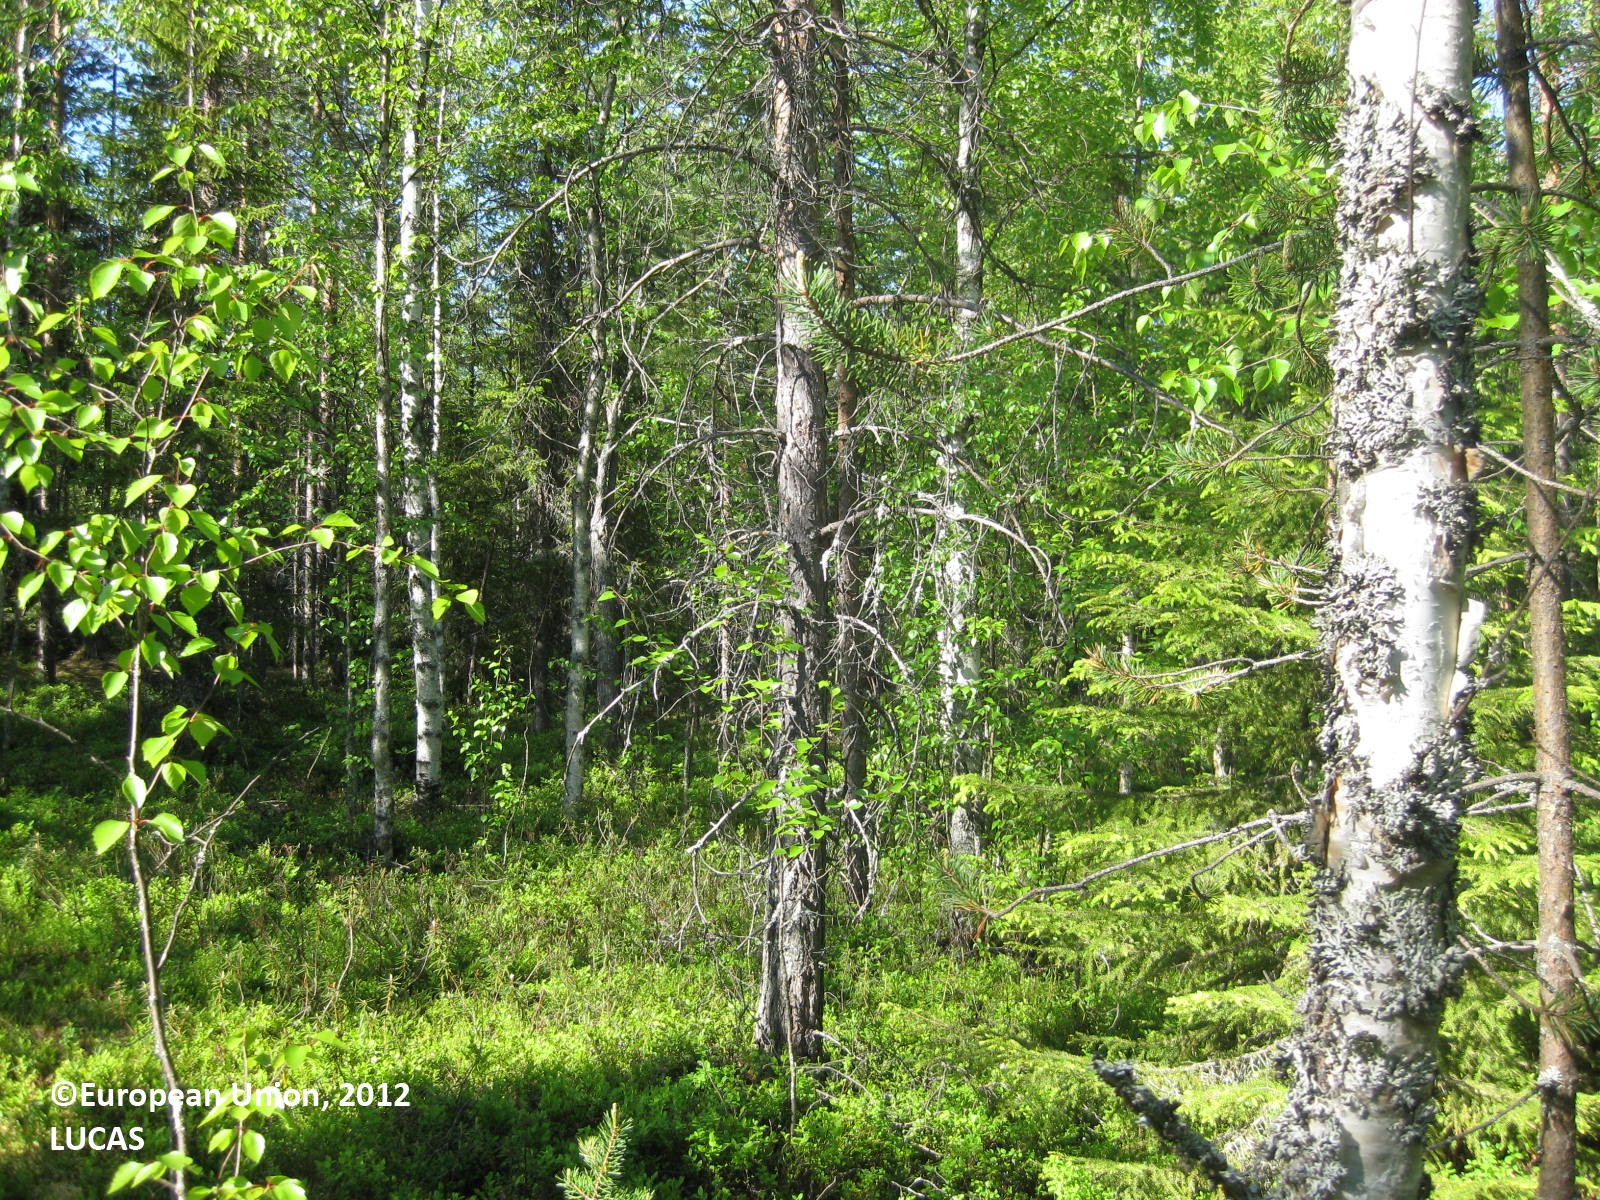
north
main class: Woodland
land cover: Pine dominated mixed woodland
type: boreal forest
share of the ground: > 75 %
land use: Forestry
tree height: > 5 m
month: June
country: FI
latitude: 65.0567
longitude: 29.0818
